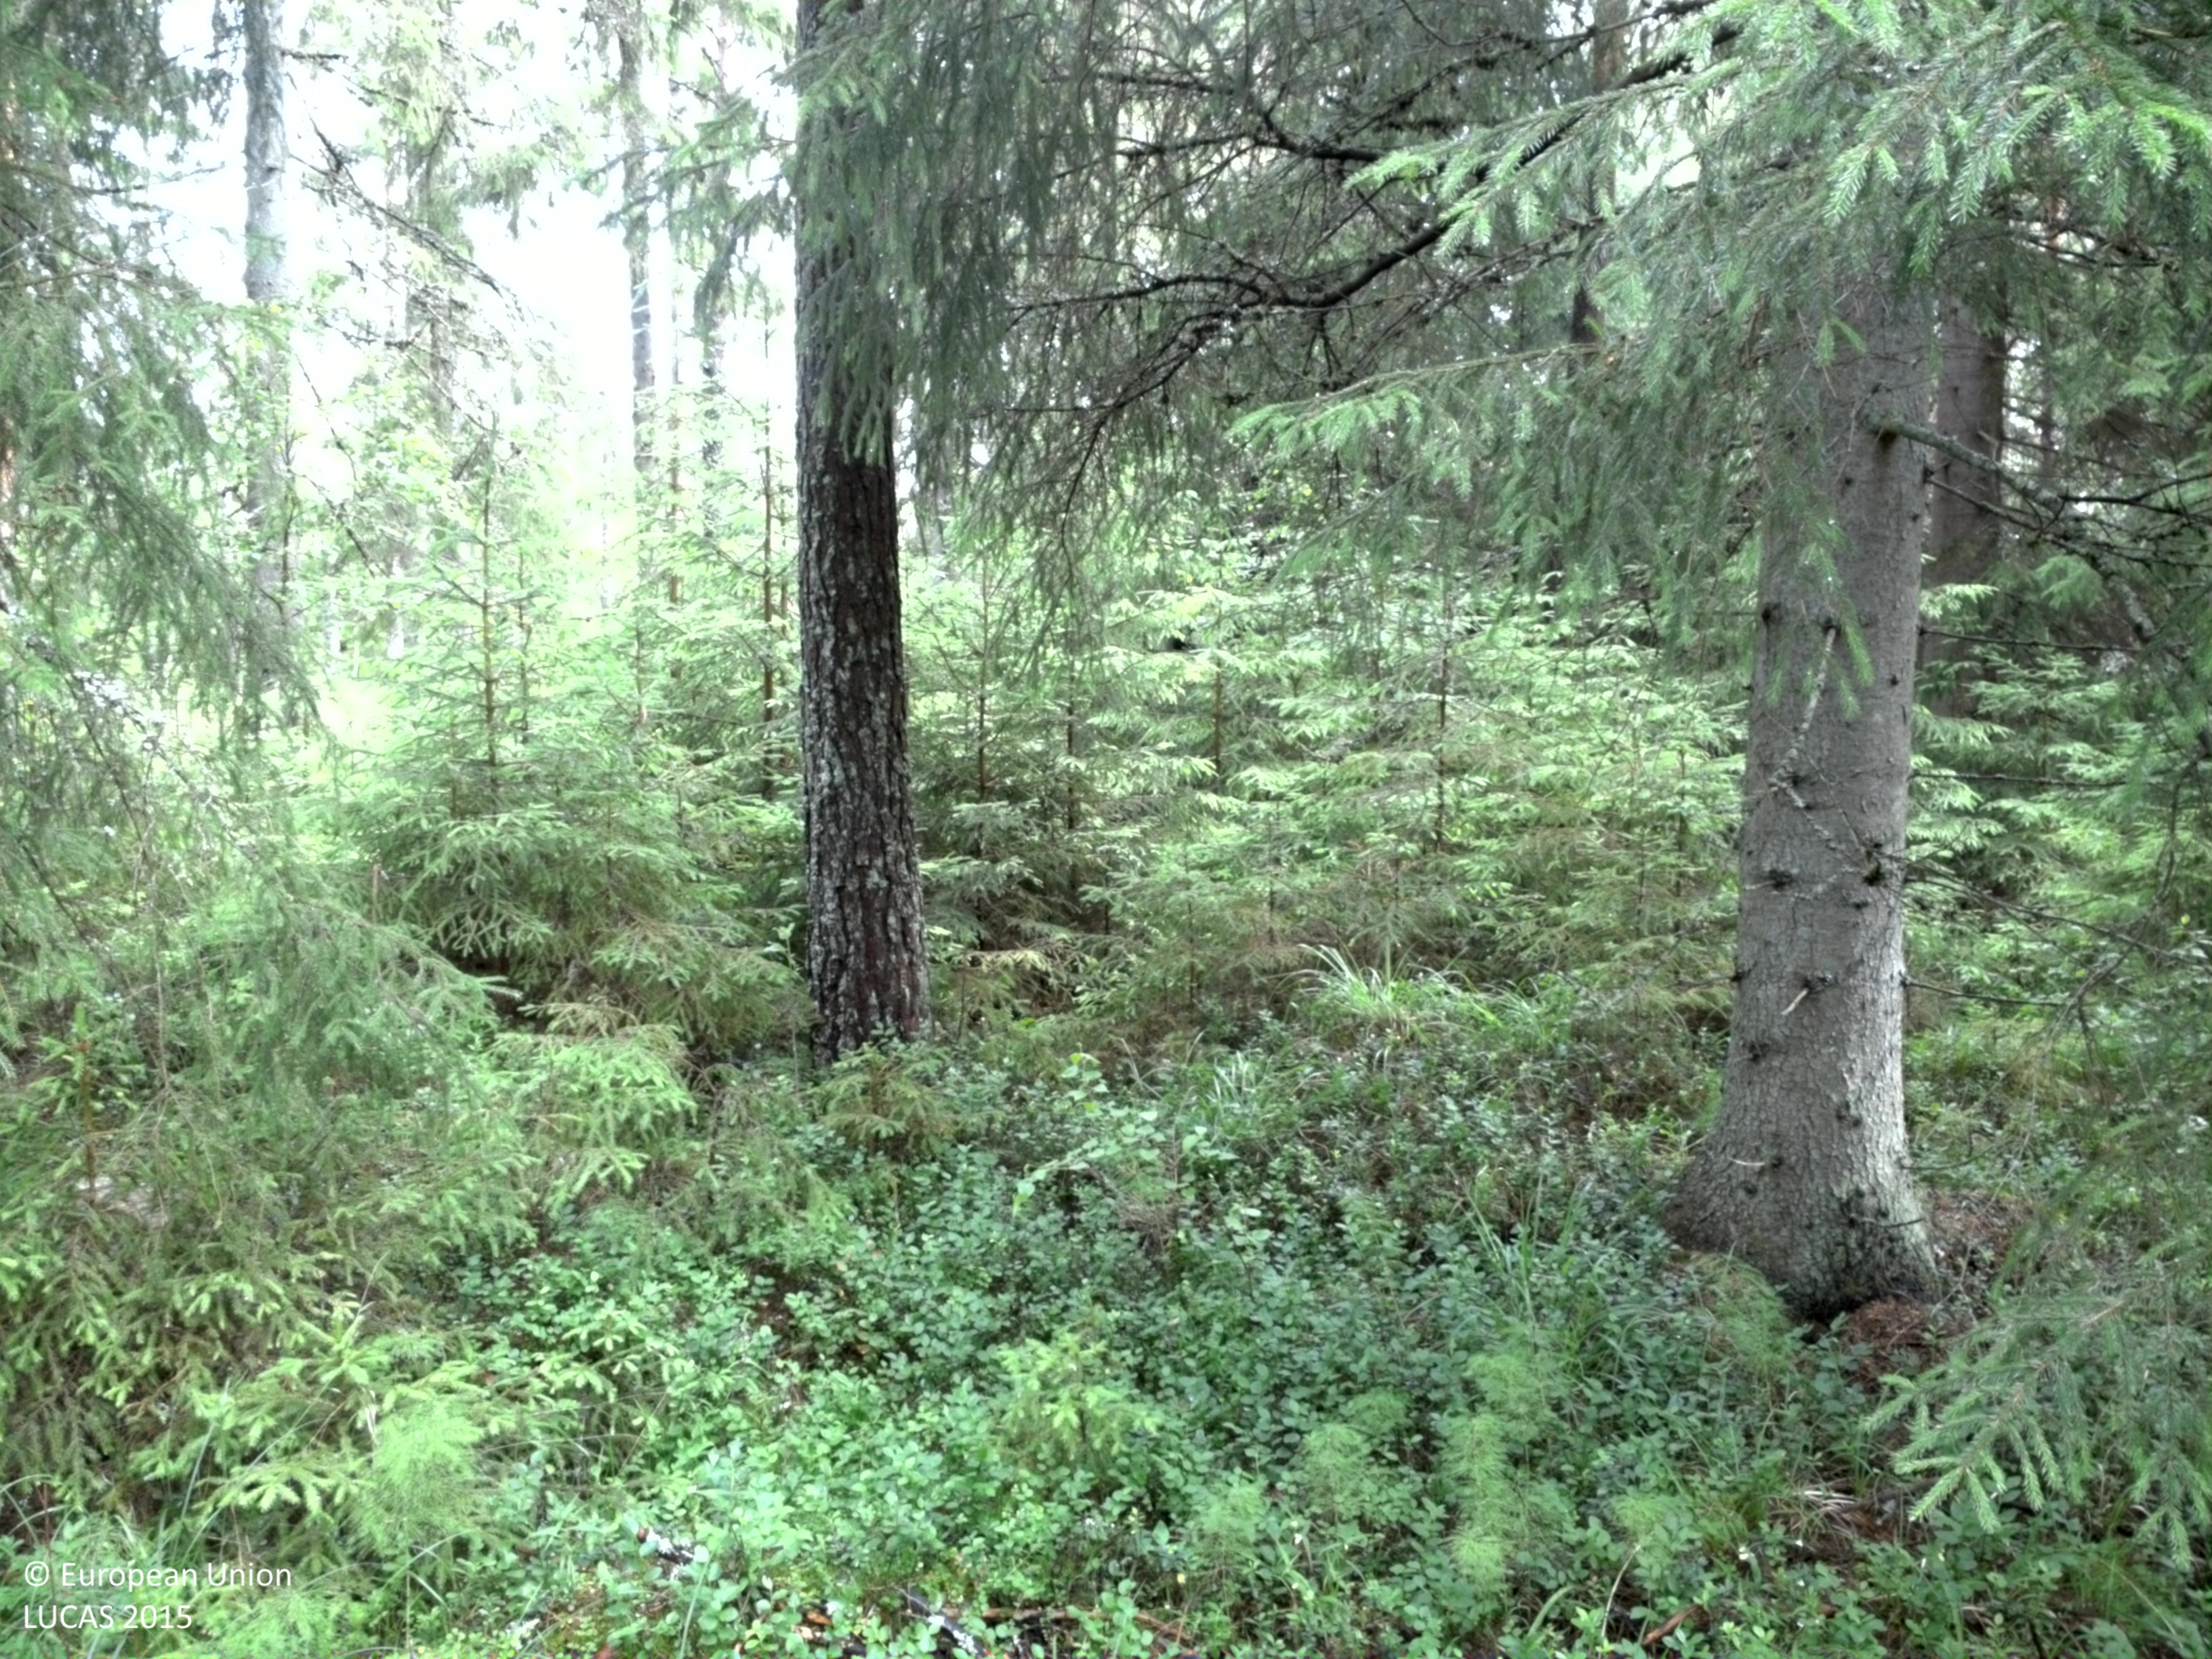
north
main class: Woodland
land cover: Spruce dominated coniferous woodland
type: boreal forest
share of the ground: 50 - 75 %
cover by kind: coniferous forest trees 70 %, herbaceous plants 25 %, broadleaved forest trees 5 %
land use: Forestry
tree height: > 5 m
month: July
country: SE
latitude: 60.0531
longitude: 17.1575
